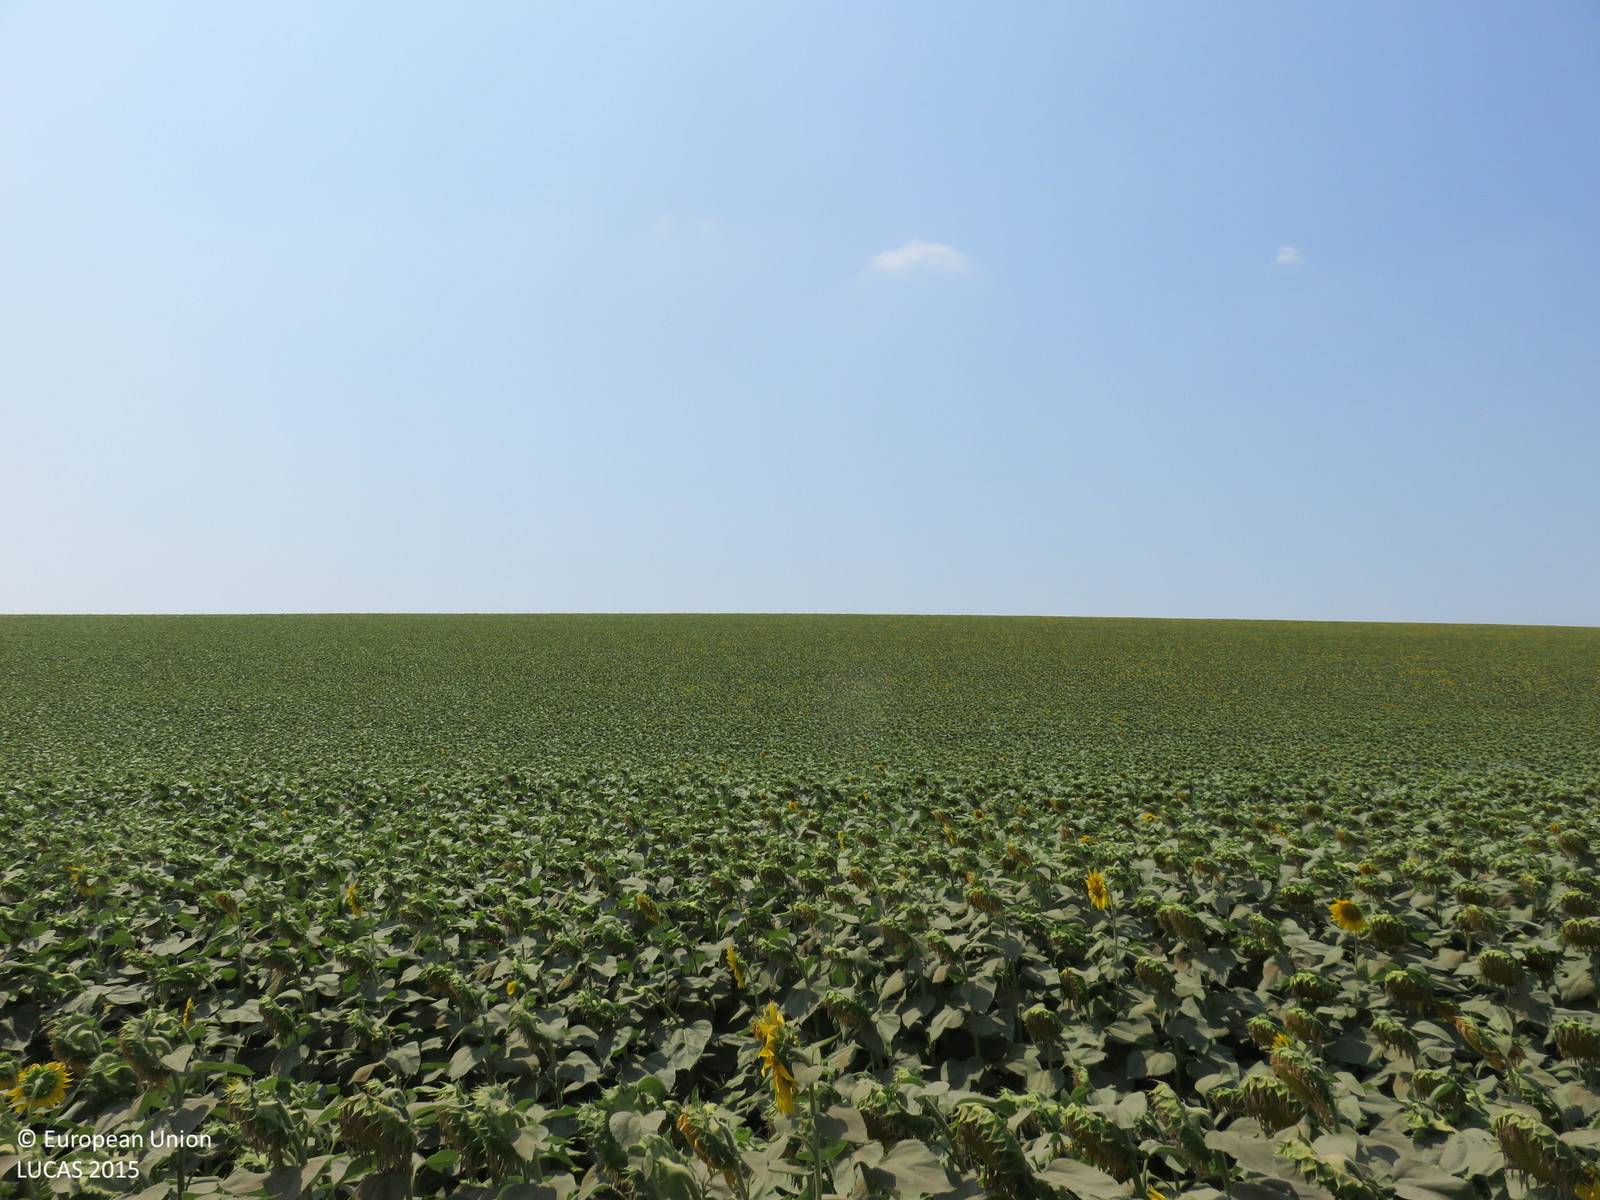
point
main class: Cropland
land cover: Sunflower
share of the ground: > 75 %
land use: Agriculture (excluding fallow land and kitchen gardens)
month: July
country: BG
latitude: 43.5441
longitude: 25.1366
